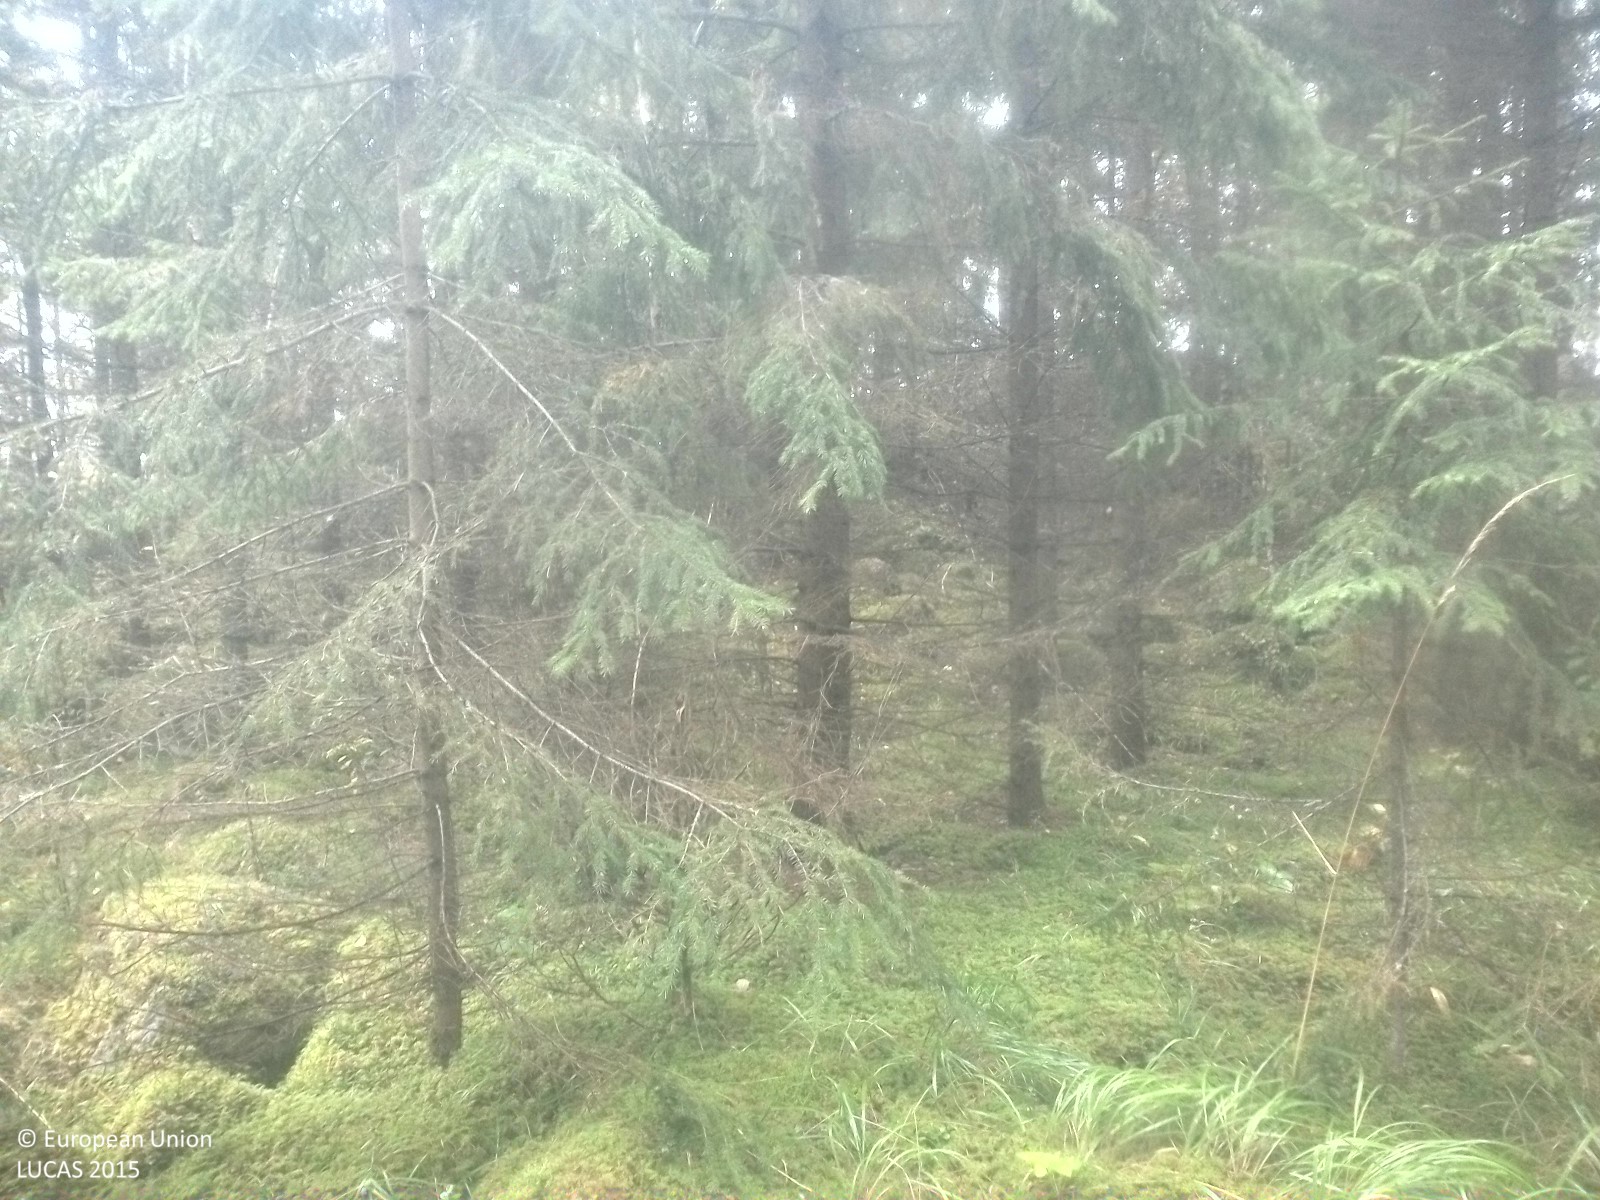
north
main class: Woodland
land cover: Spruce dominated coniferous woodland
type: boreal forest
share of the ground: 50 - 75 %
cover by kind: coniferous forest trees 60 %, lichens and mosses 30 %, herbaceous plants 10 %
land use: Forestry
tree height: > 5 m
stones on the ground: 10 - 25 %
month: September
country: SE
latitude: 58.7969
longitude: 15.8257
